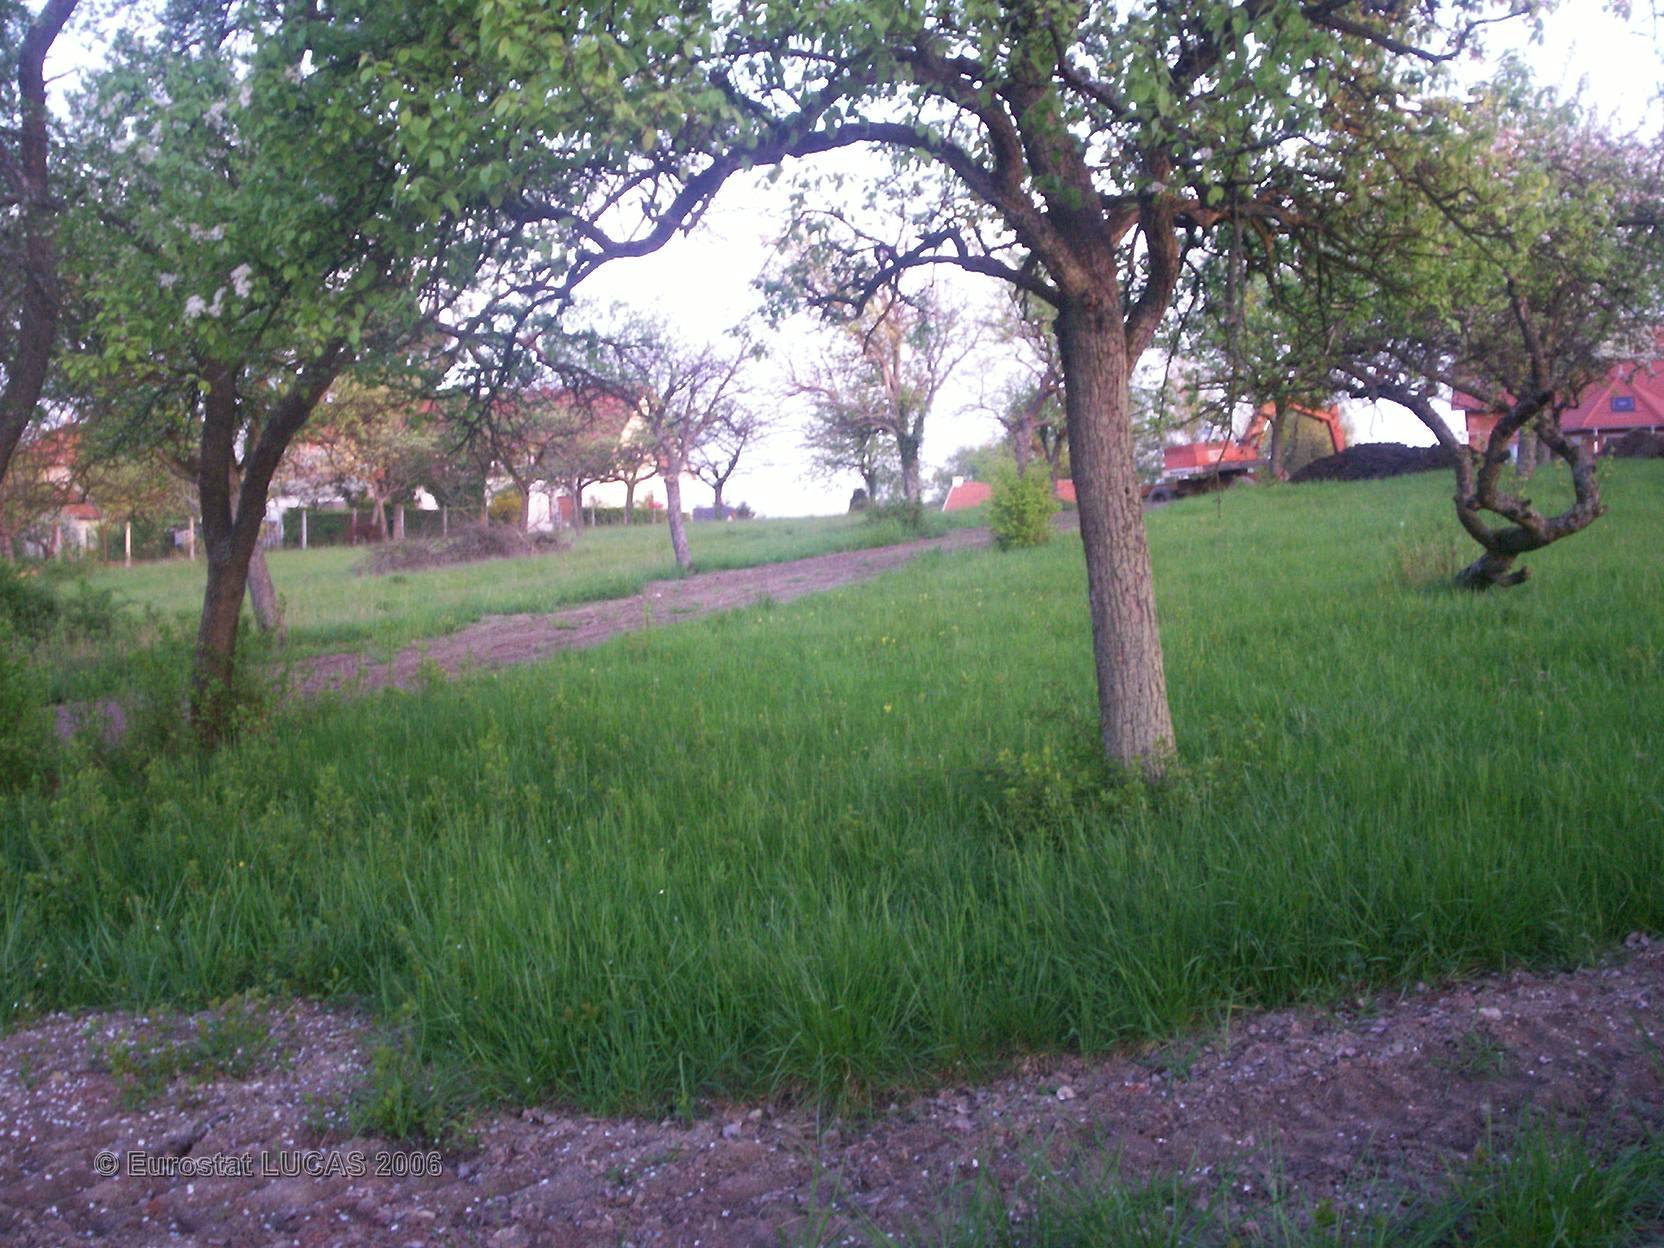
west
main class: Cropland
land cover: Apple fruit
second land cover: Grassland with sparse tree/shrub cover
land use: Agriculture (excluding fallow land and kitchen gardens)
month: May
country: FR
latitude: 49.0463
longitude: 6.9768
